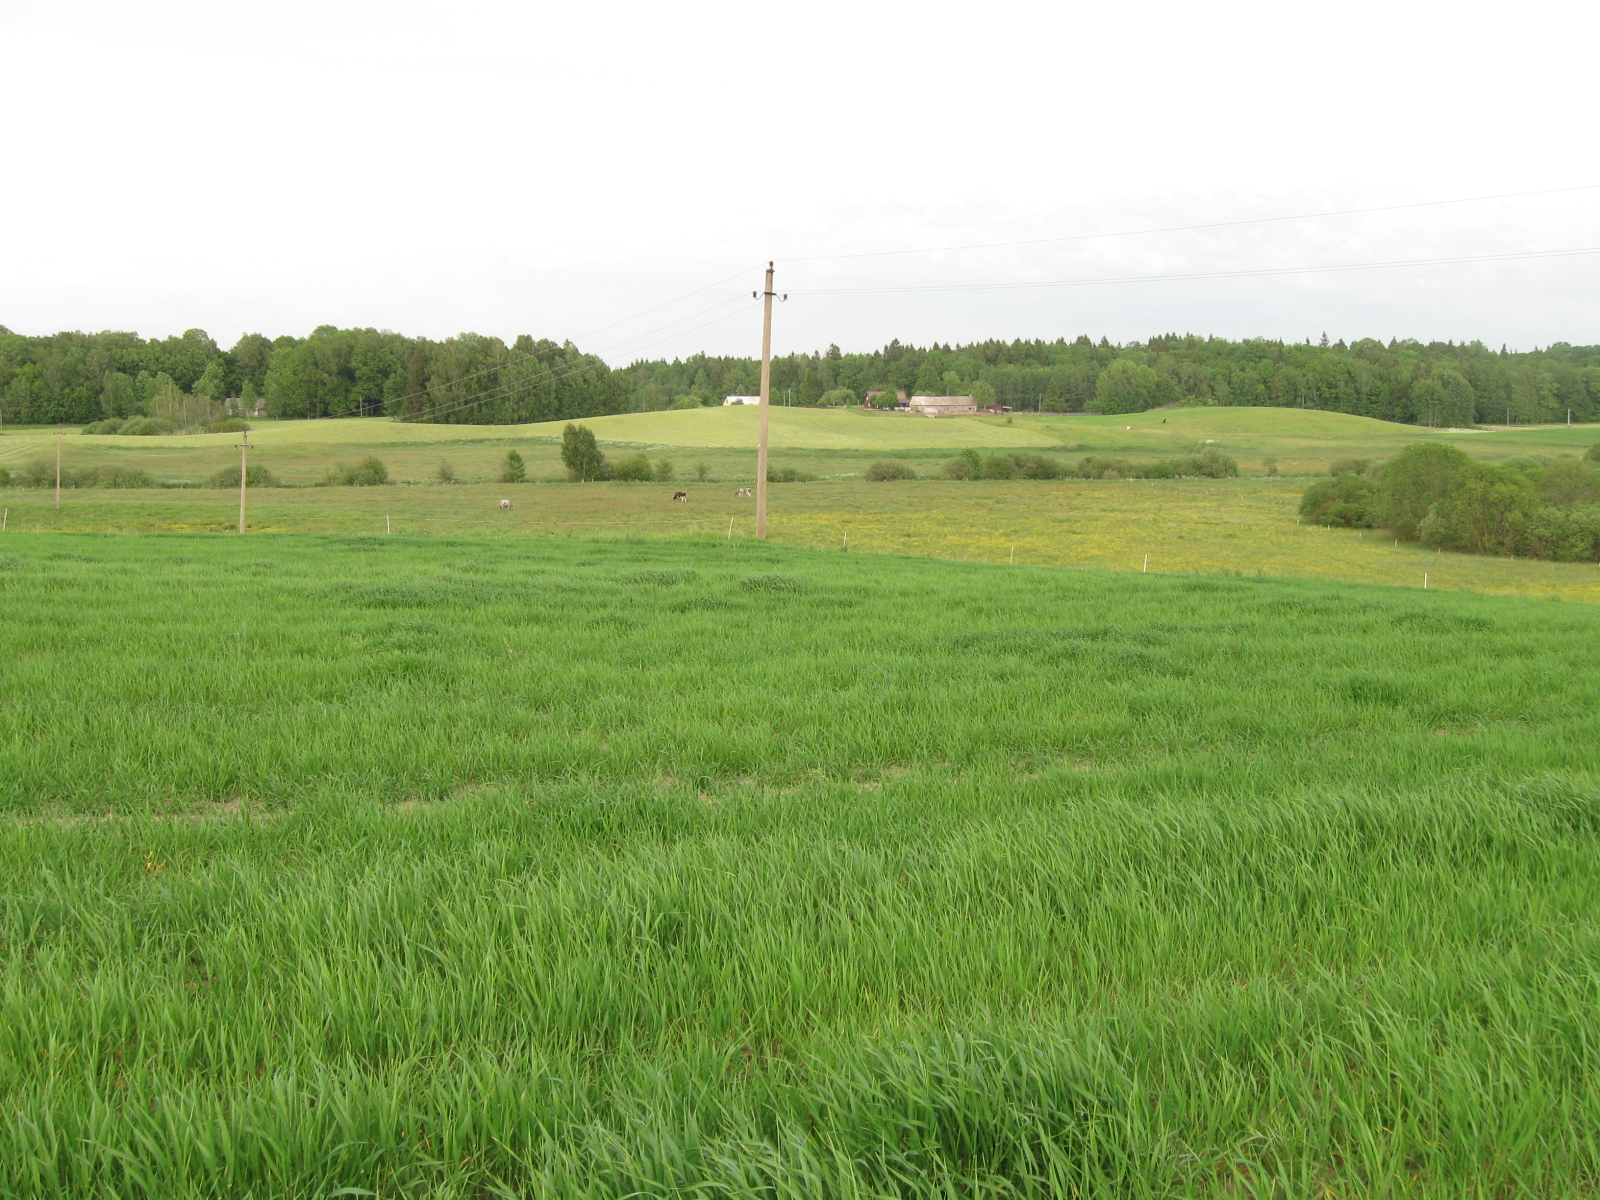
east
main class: Cropland
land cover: Barley
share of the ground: > 75 %
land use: Agriculture (excluding fallow land and kitchen gardens)
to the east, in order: Barley; Fences; Grassland without tree/shrub cover; Electric lines; Grassland without tree/shrub cover
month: June
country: LT
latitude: 54.2675
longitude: 23.6431
